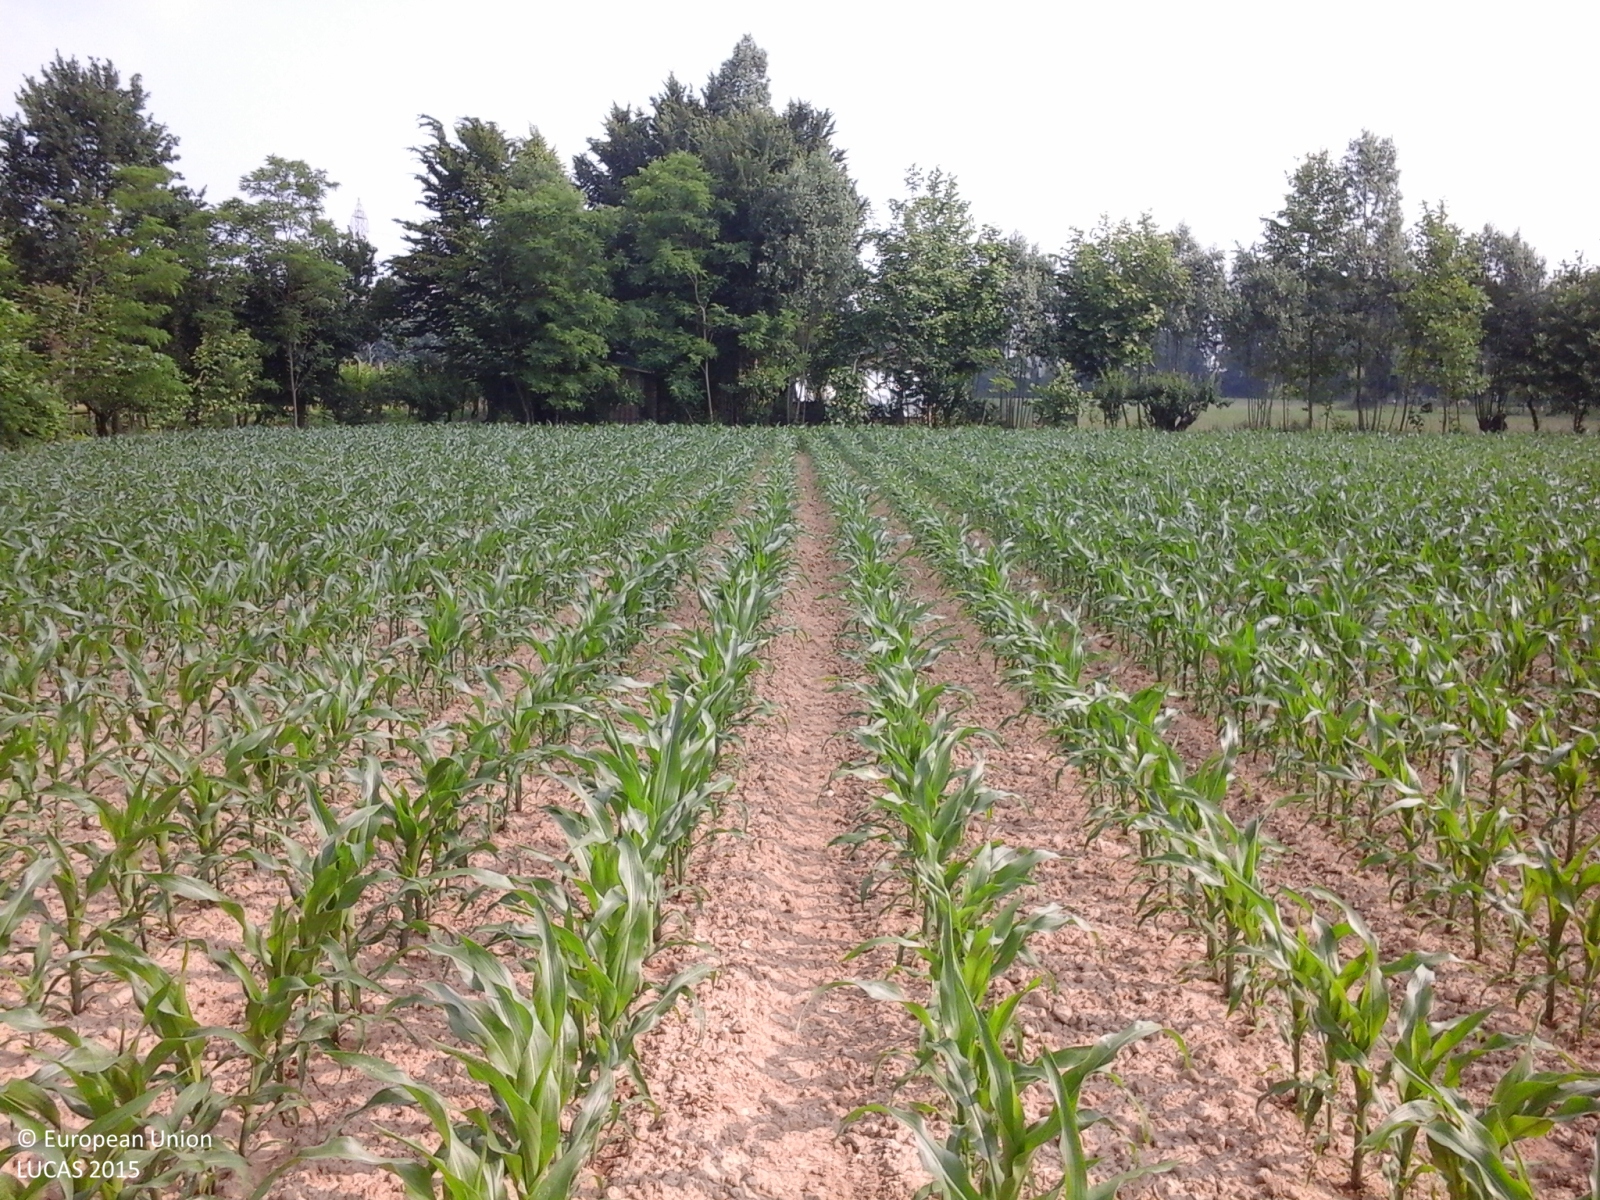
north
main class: Cropland
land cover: Maize
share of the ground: > 75 %
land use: Agriculture (excluding fallow land and kitchen gardens)
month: June
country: IT
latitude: 45.5353
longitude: 12.2120
